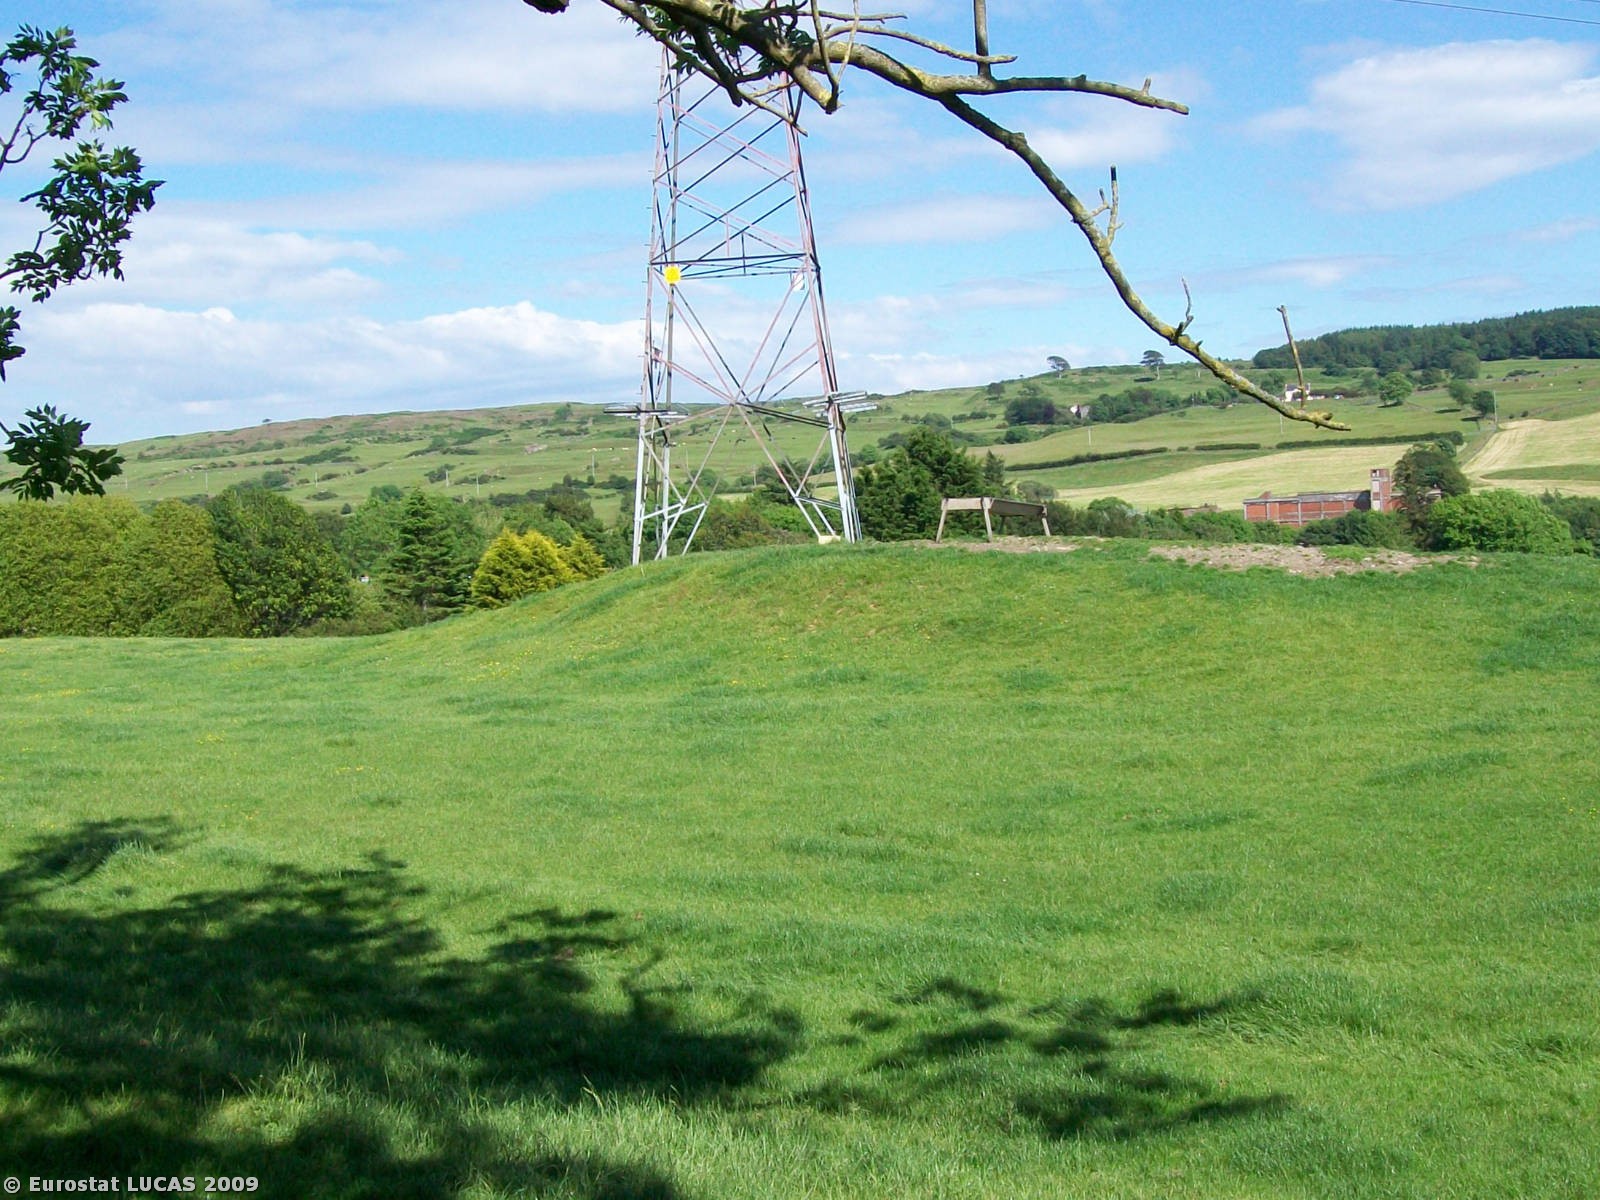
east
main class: Woodland
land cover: Broadleaved woodland
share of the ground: > 75 %
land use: Agriculture (excluding fallow land and kitchen gardens)
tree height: > 5 m
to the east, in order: Broadleaved woodland; Rivers and streams; Grassland without tree/shrub cover; Electric lines; Grassland without tree/shrub cover; Fences; Artificial constructions in urban areas; Dry stone walls; Paved roads, cycling and walking lanes; Managed hedges; Fences; Grassland without tree/shrub cover; Other structural elements
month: June
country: GB
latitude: 54.8626
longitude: -4.0358
